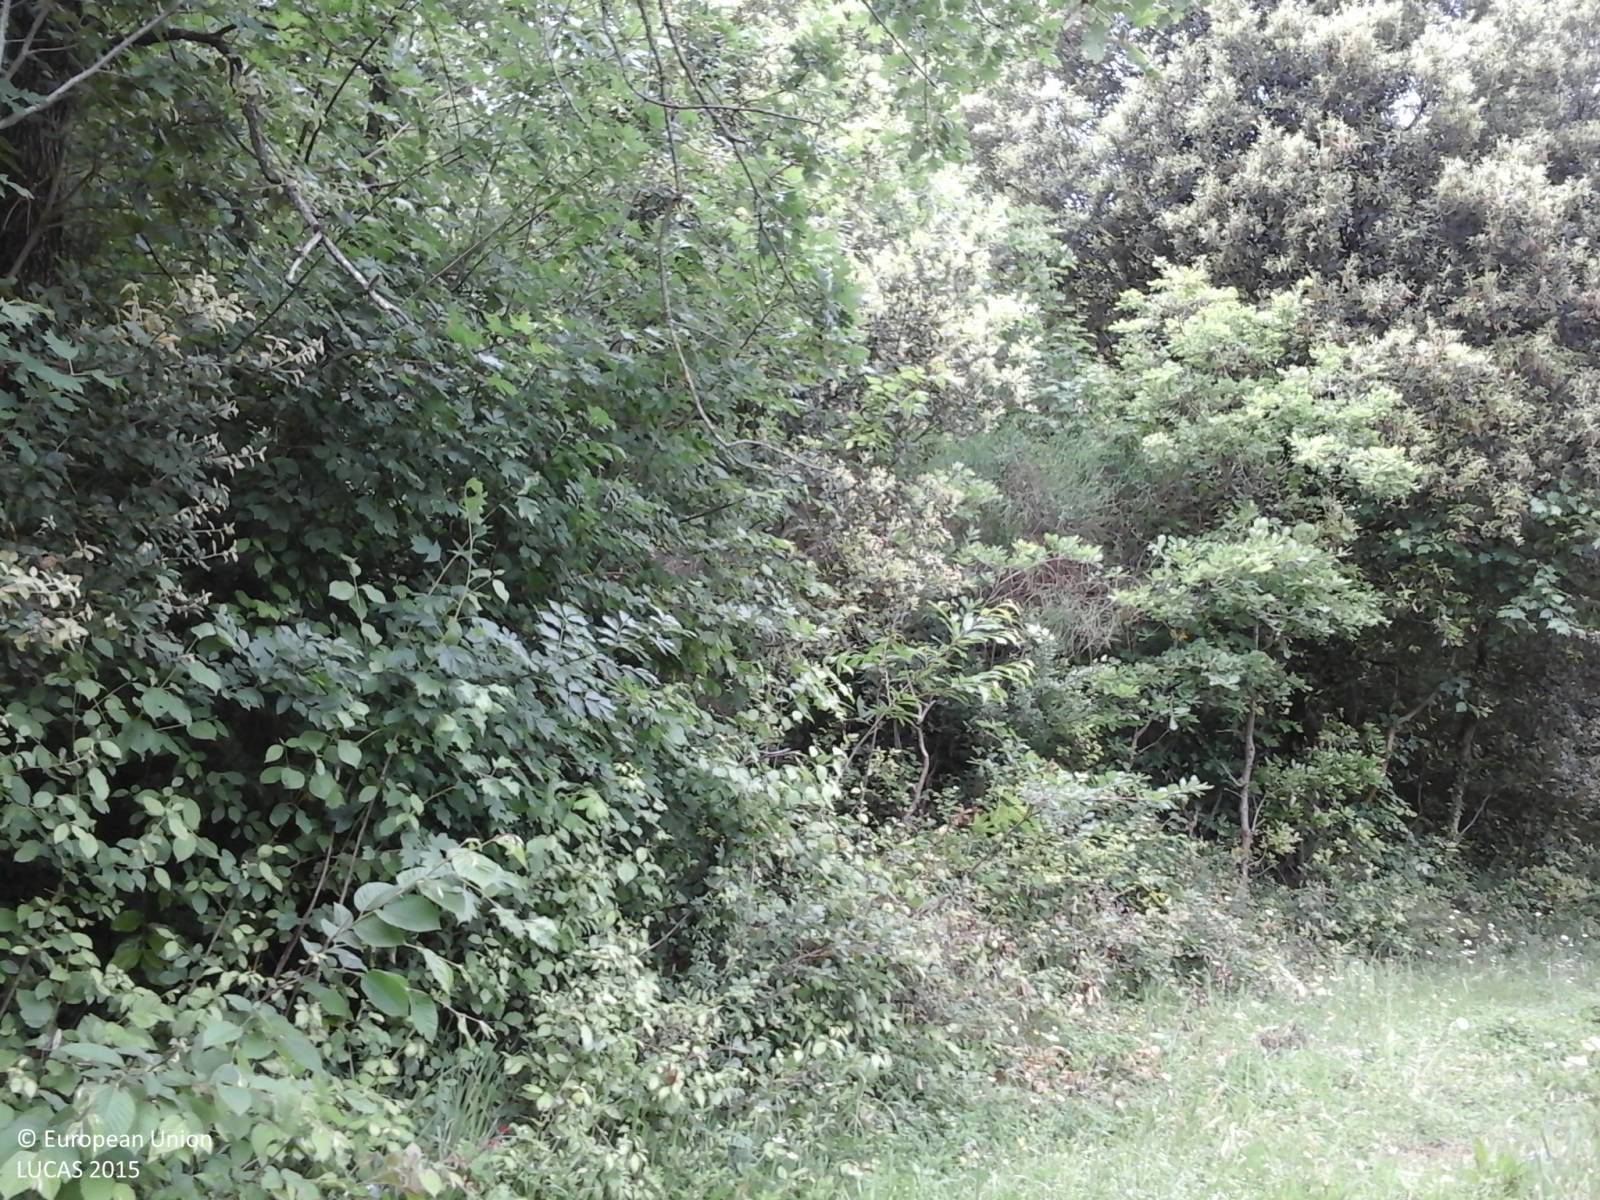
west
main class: Woodland
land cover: Broadleaved woodland
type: thermophilous deciduous forest
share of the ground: > 75 %
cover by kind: broadleaved forest trees 100 %
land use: Forestry
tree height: < 5 m
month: May
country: IT
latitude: 41.2092
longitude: 14.2174
